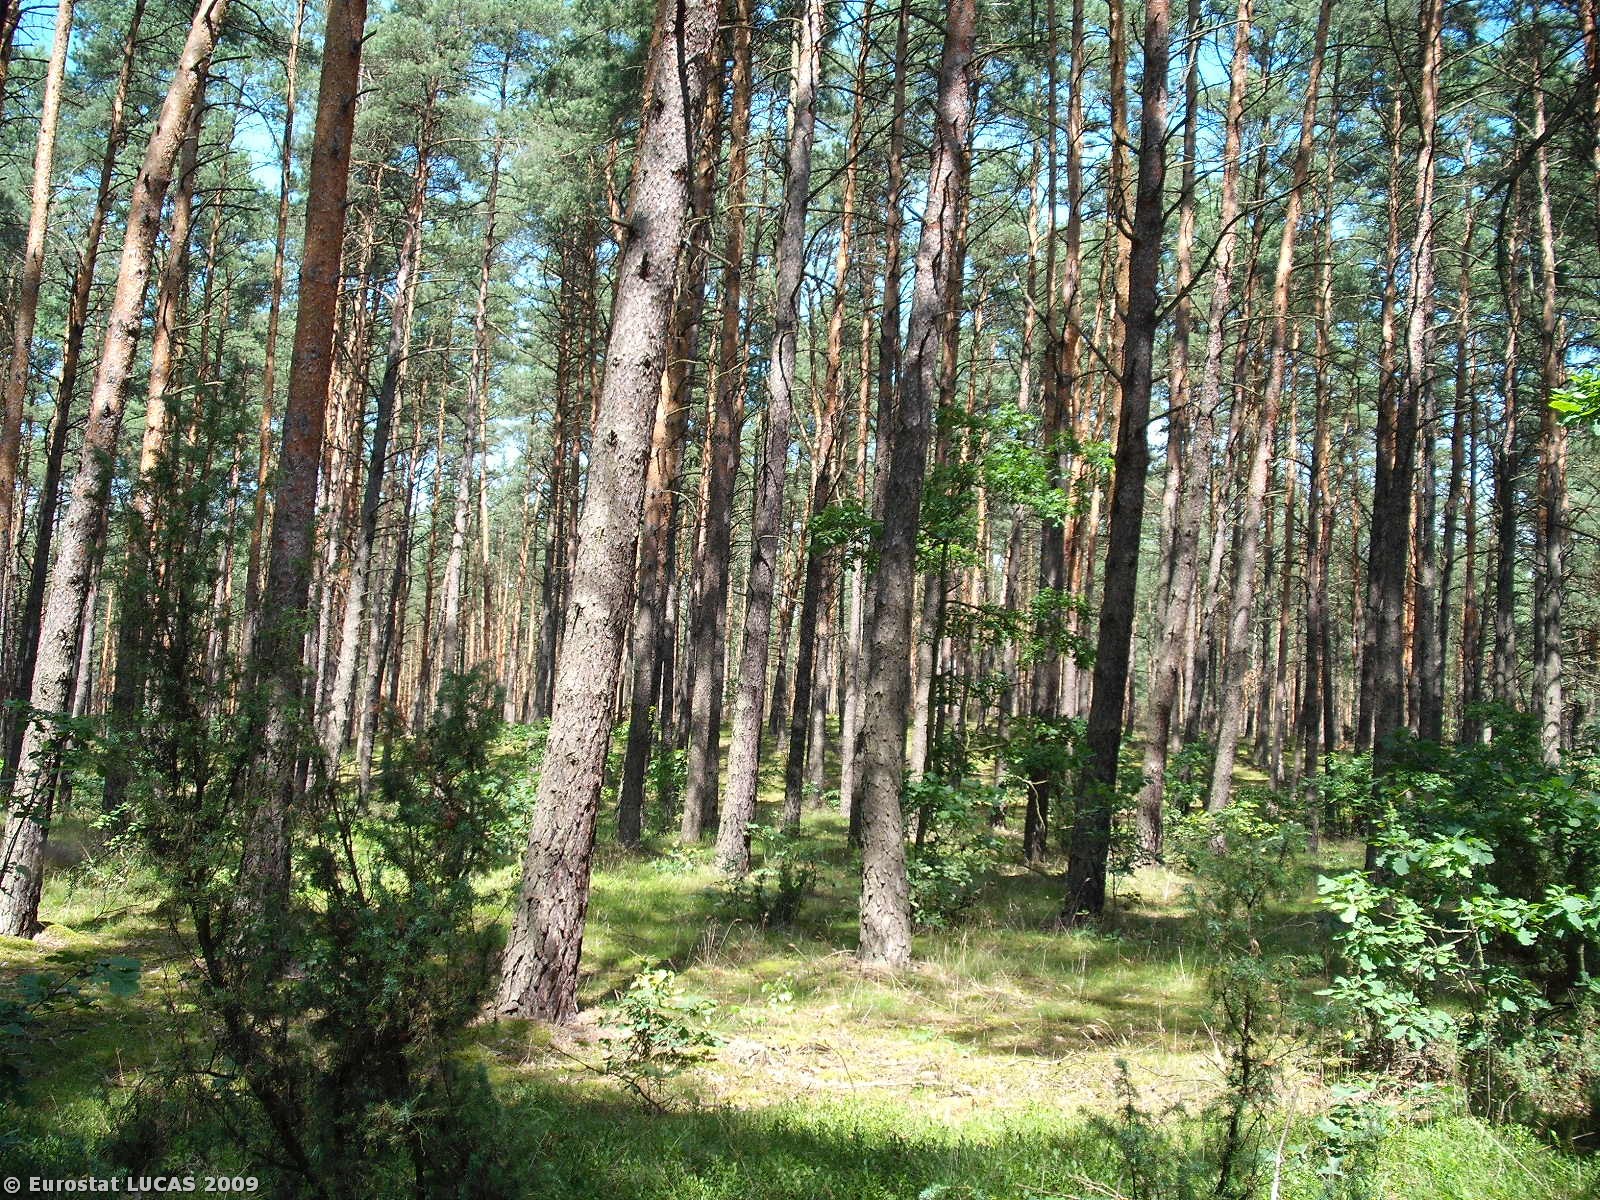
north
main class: Woodland
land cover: Coniferous woodland
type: hemiboreal forest and nemoral coniferous forest and mixed broadleaved-coniferous forest
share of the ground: > 75 %
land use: Forestry
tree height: > 5 m
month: July
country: PL
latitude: 52.3244
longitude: 20.7371
